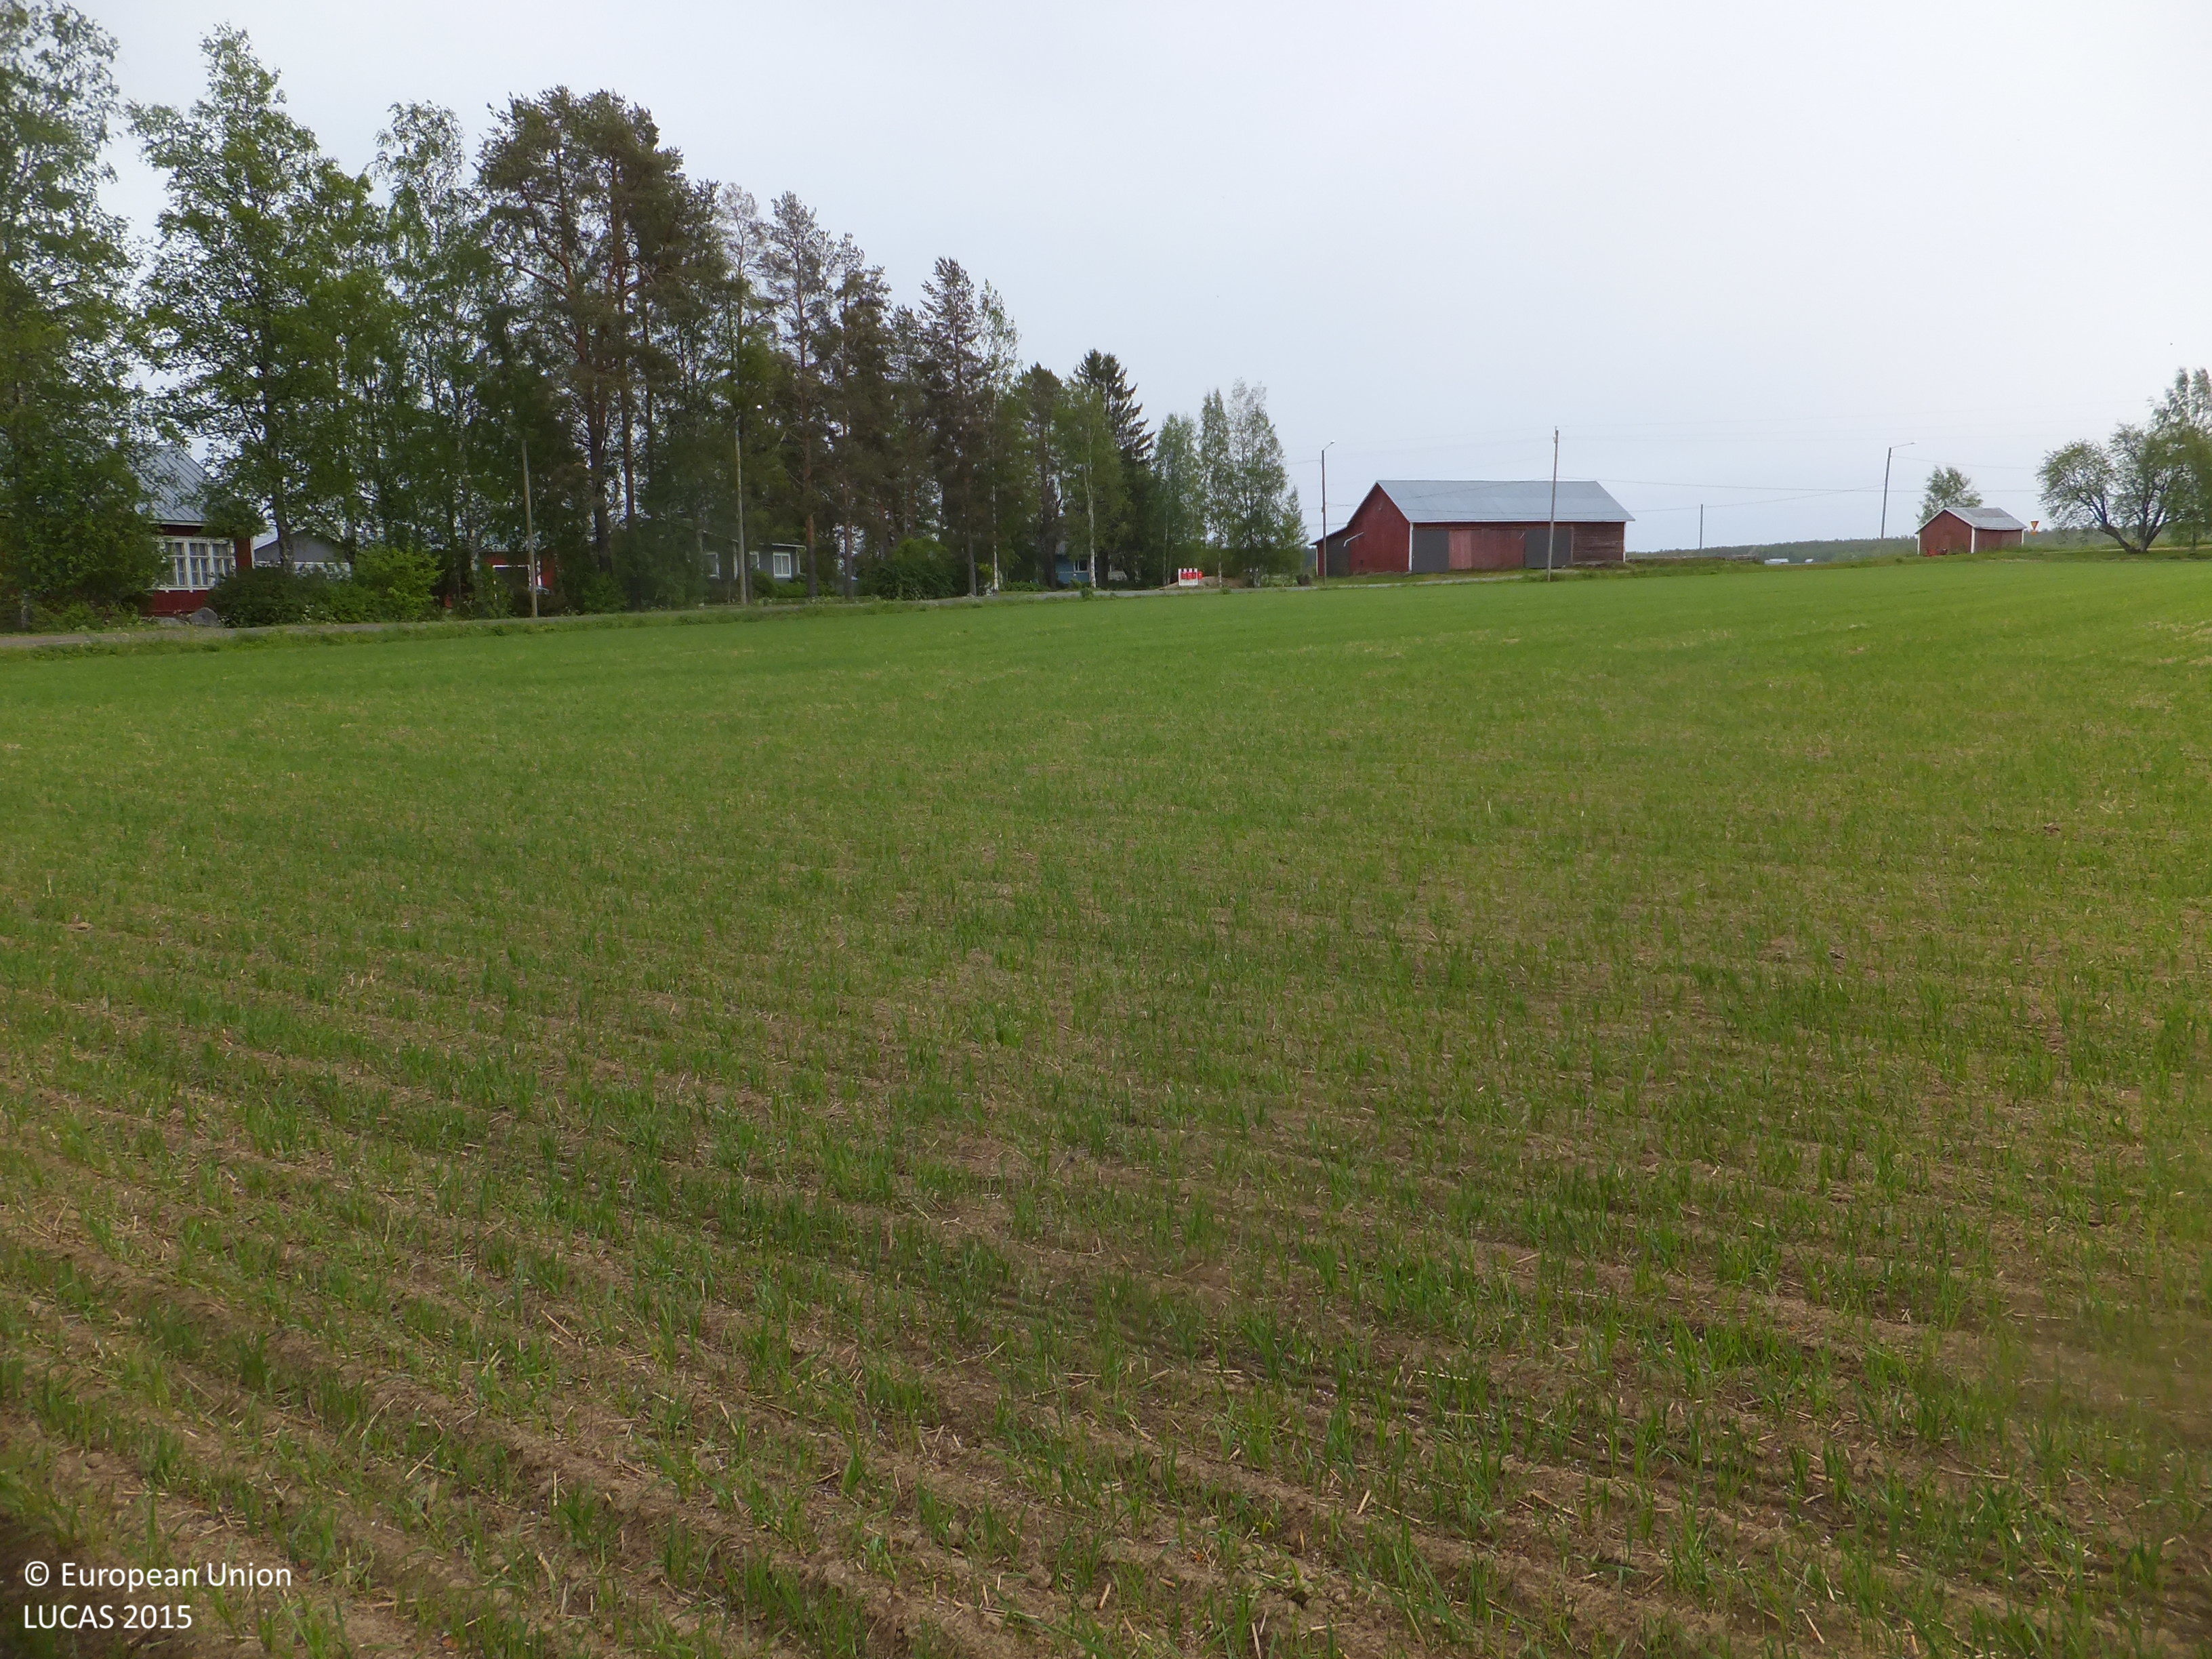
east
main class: Cropland
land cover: Common wheat
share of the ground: 10 - 25 %
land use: Agriculture (excluding fallow land and kitchen gardens)
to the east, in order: Common wheat; Ditches and canals; Grass margins; Artificial constructions in urban areas; Ditches and canals; Barley
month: June
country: FI
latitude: 63.2300
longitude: 22.6485
